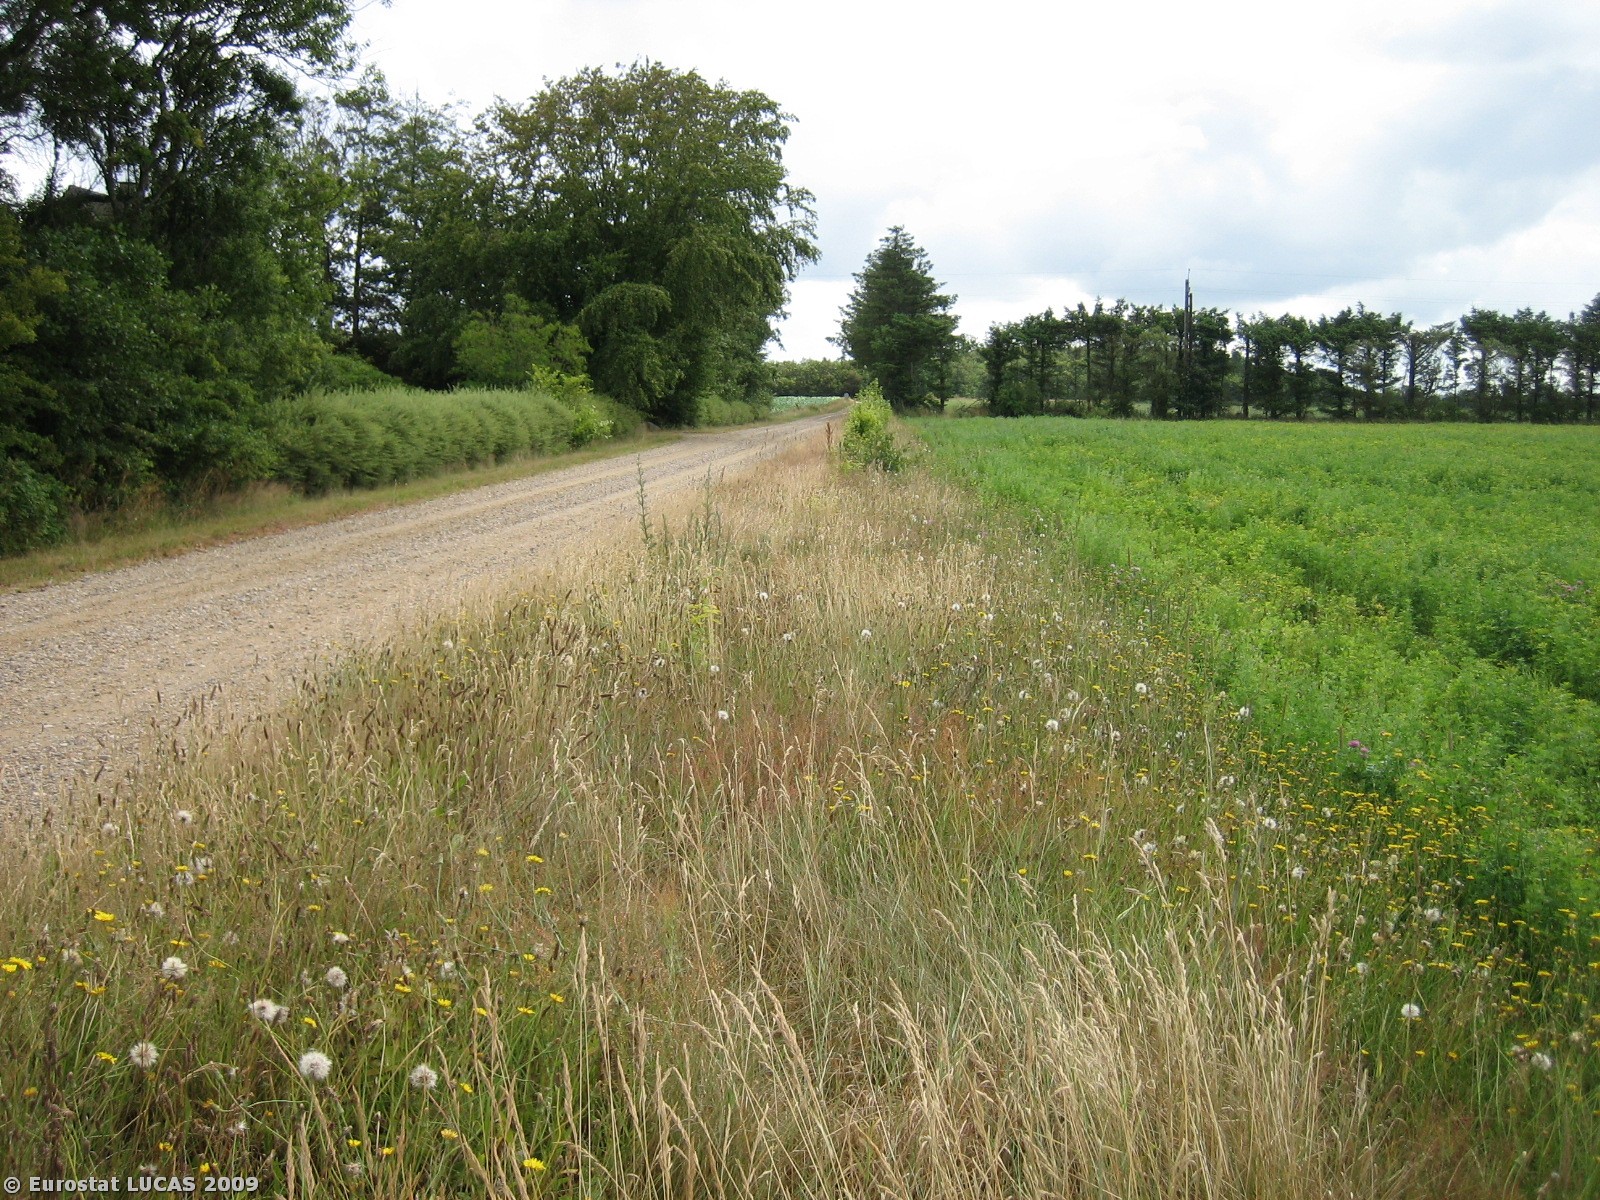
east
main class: Cropland
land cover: Clovers
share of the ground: > 75 %
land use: Agriculture (excluding fallow land and kitchen gardens)
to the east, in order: Clovers; Electric lines; Clovers; Coniferous woodland; Clovers
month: July
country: DK
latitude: 55.8372
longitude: 8.4846
